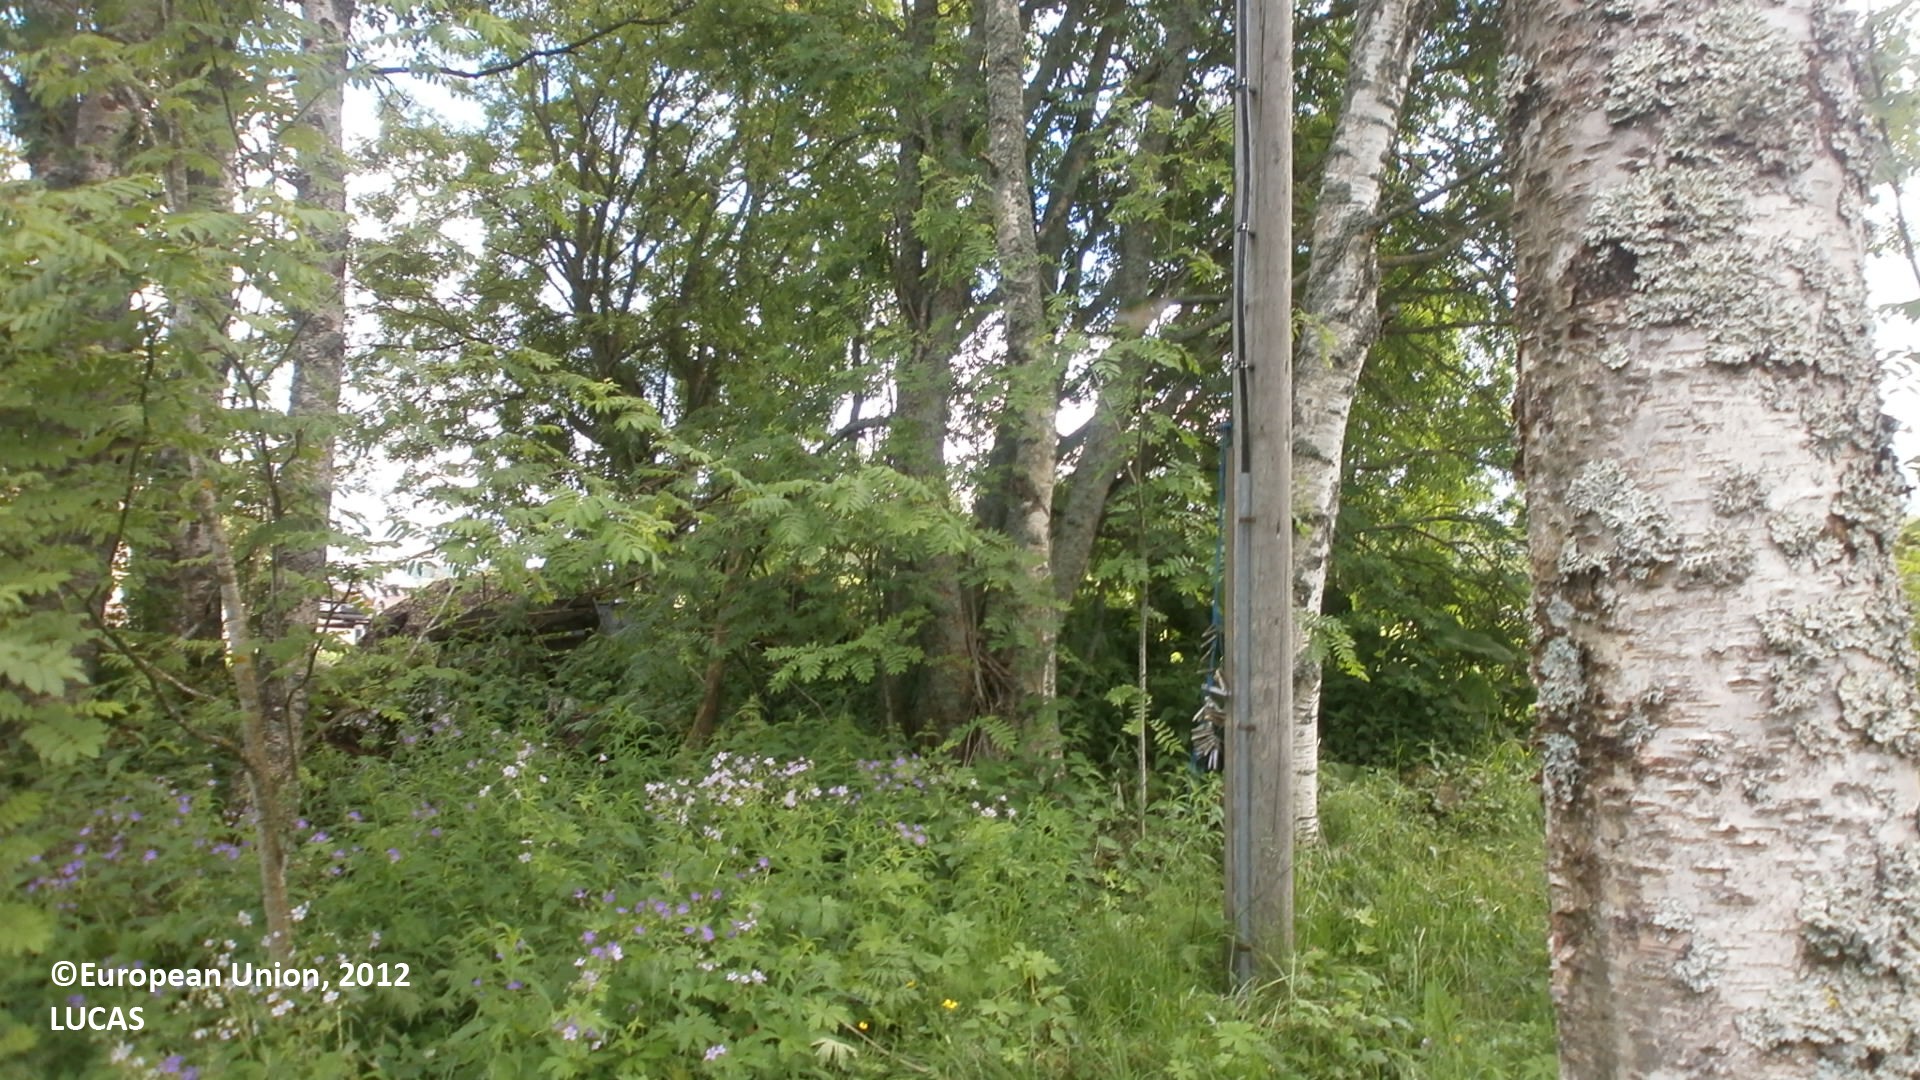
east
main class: Woodland
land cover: Broadleaved woodland
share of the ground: 50 - 75 %
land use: Residential
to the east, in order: Broadleaved woodland; Electric lines; Broadleaved woodland; Grassland without tree/shrub cover; Tracks; Grassland without tree/shrub cover; Shrubland without tree cover; Ditches and canals; Grass margins; Paved roads, cycling and walking lanes; Grassland without tree/shrub cover; Ditches and canals; Shruby margins; Temporary grasslands; Shruby margins; Ditches and canals; Spontaneously vegetated surfaces; Paved roads, cycling and walking lanes; Spontaneously vegetated surfaces; Paved roads, cycling and walking lanes; Shruby margins; Electric lines; Shruby margins; Ditches and canals; Shruby margins; Pine dominated mixed woodland; Spruce dominated mixed woodland; Managed hedges; Grassland without tree/shrub cover; Artificial constructions in urban areas
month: June
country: FI
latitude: 64.2984
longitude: 24.8971
